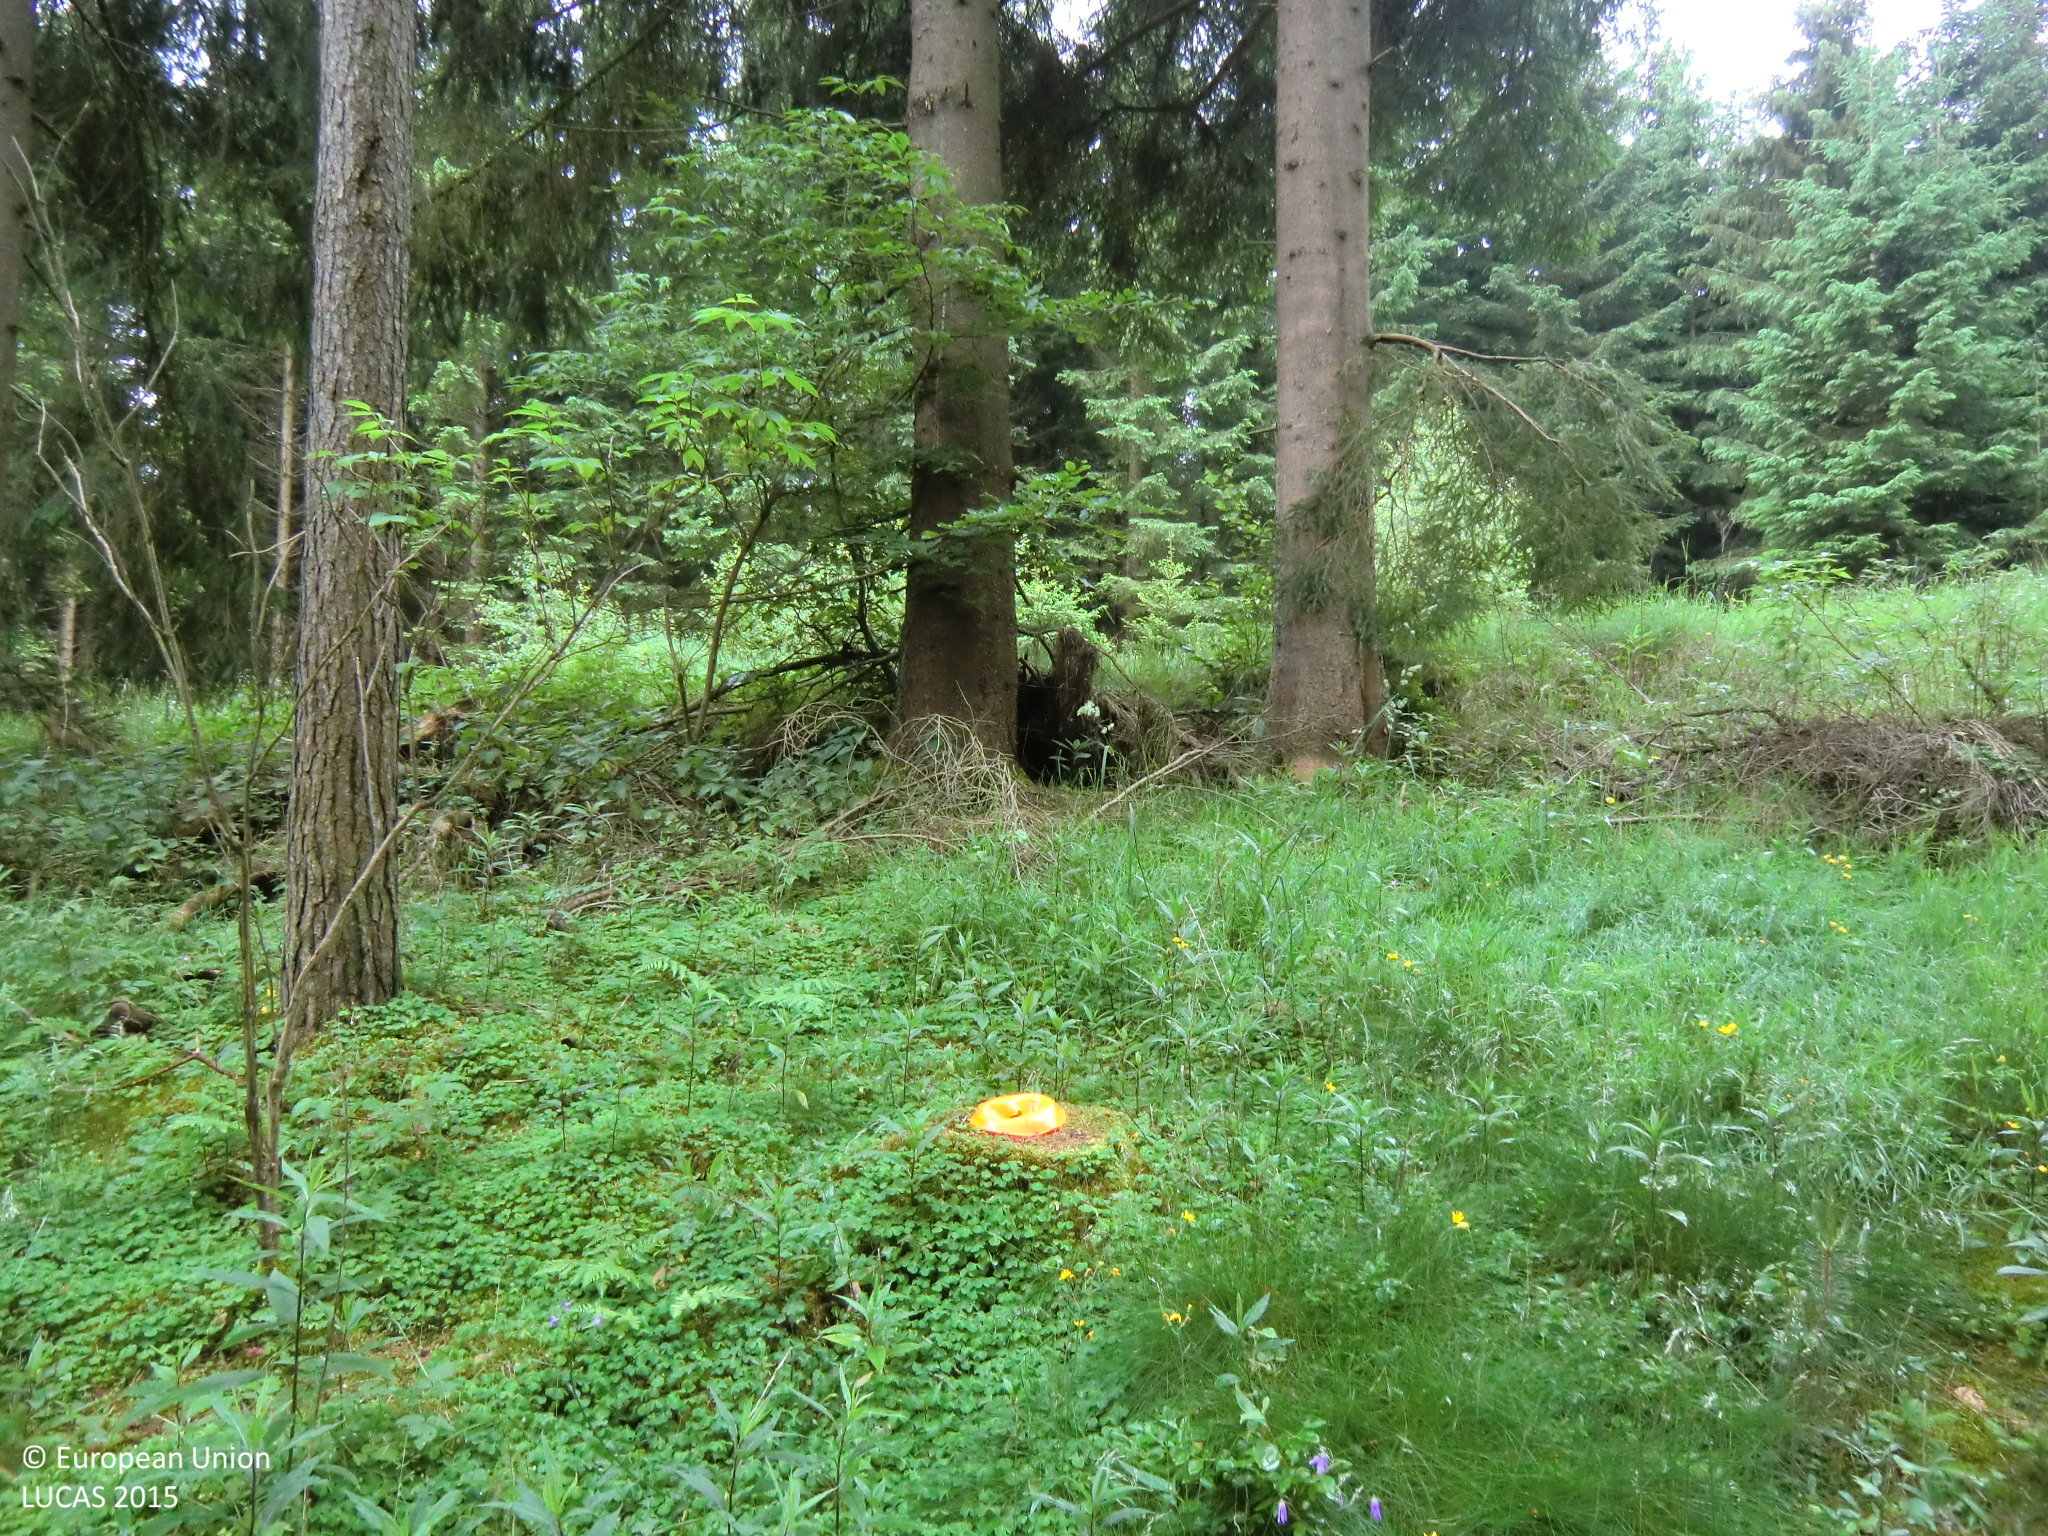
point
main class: Woodland
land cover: Spruce dominated coniferous woodland
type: hemiboreal forest and nemoral coniferous forest and mixed broadleaved-coniferous forest
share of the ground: > 75 %
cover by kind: coniferous forest trees 75 %, herbaceous plants 15 %, shrubs 10 %
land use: Forestry
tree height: > 5 m
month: June
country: AT
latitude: 48.4806
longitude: 14.7767
